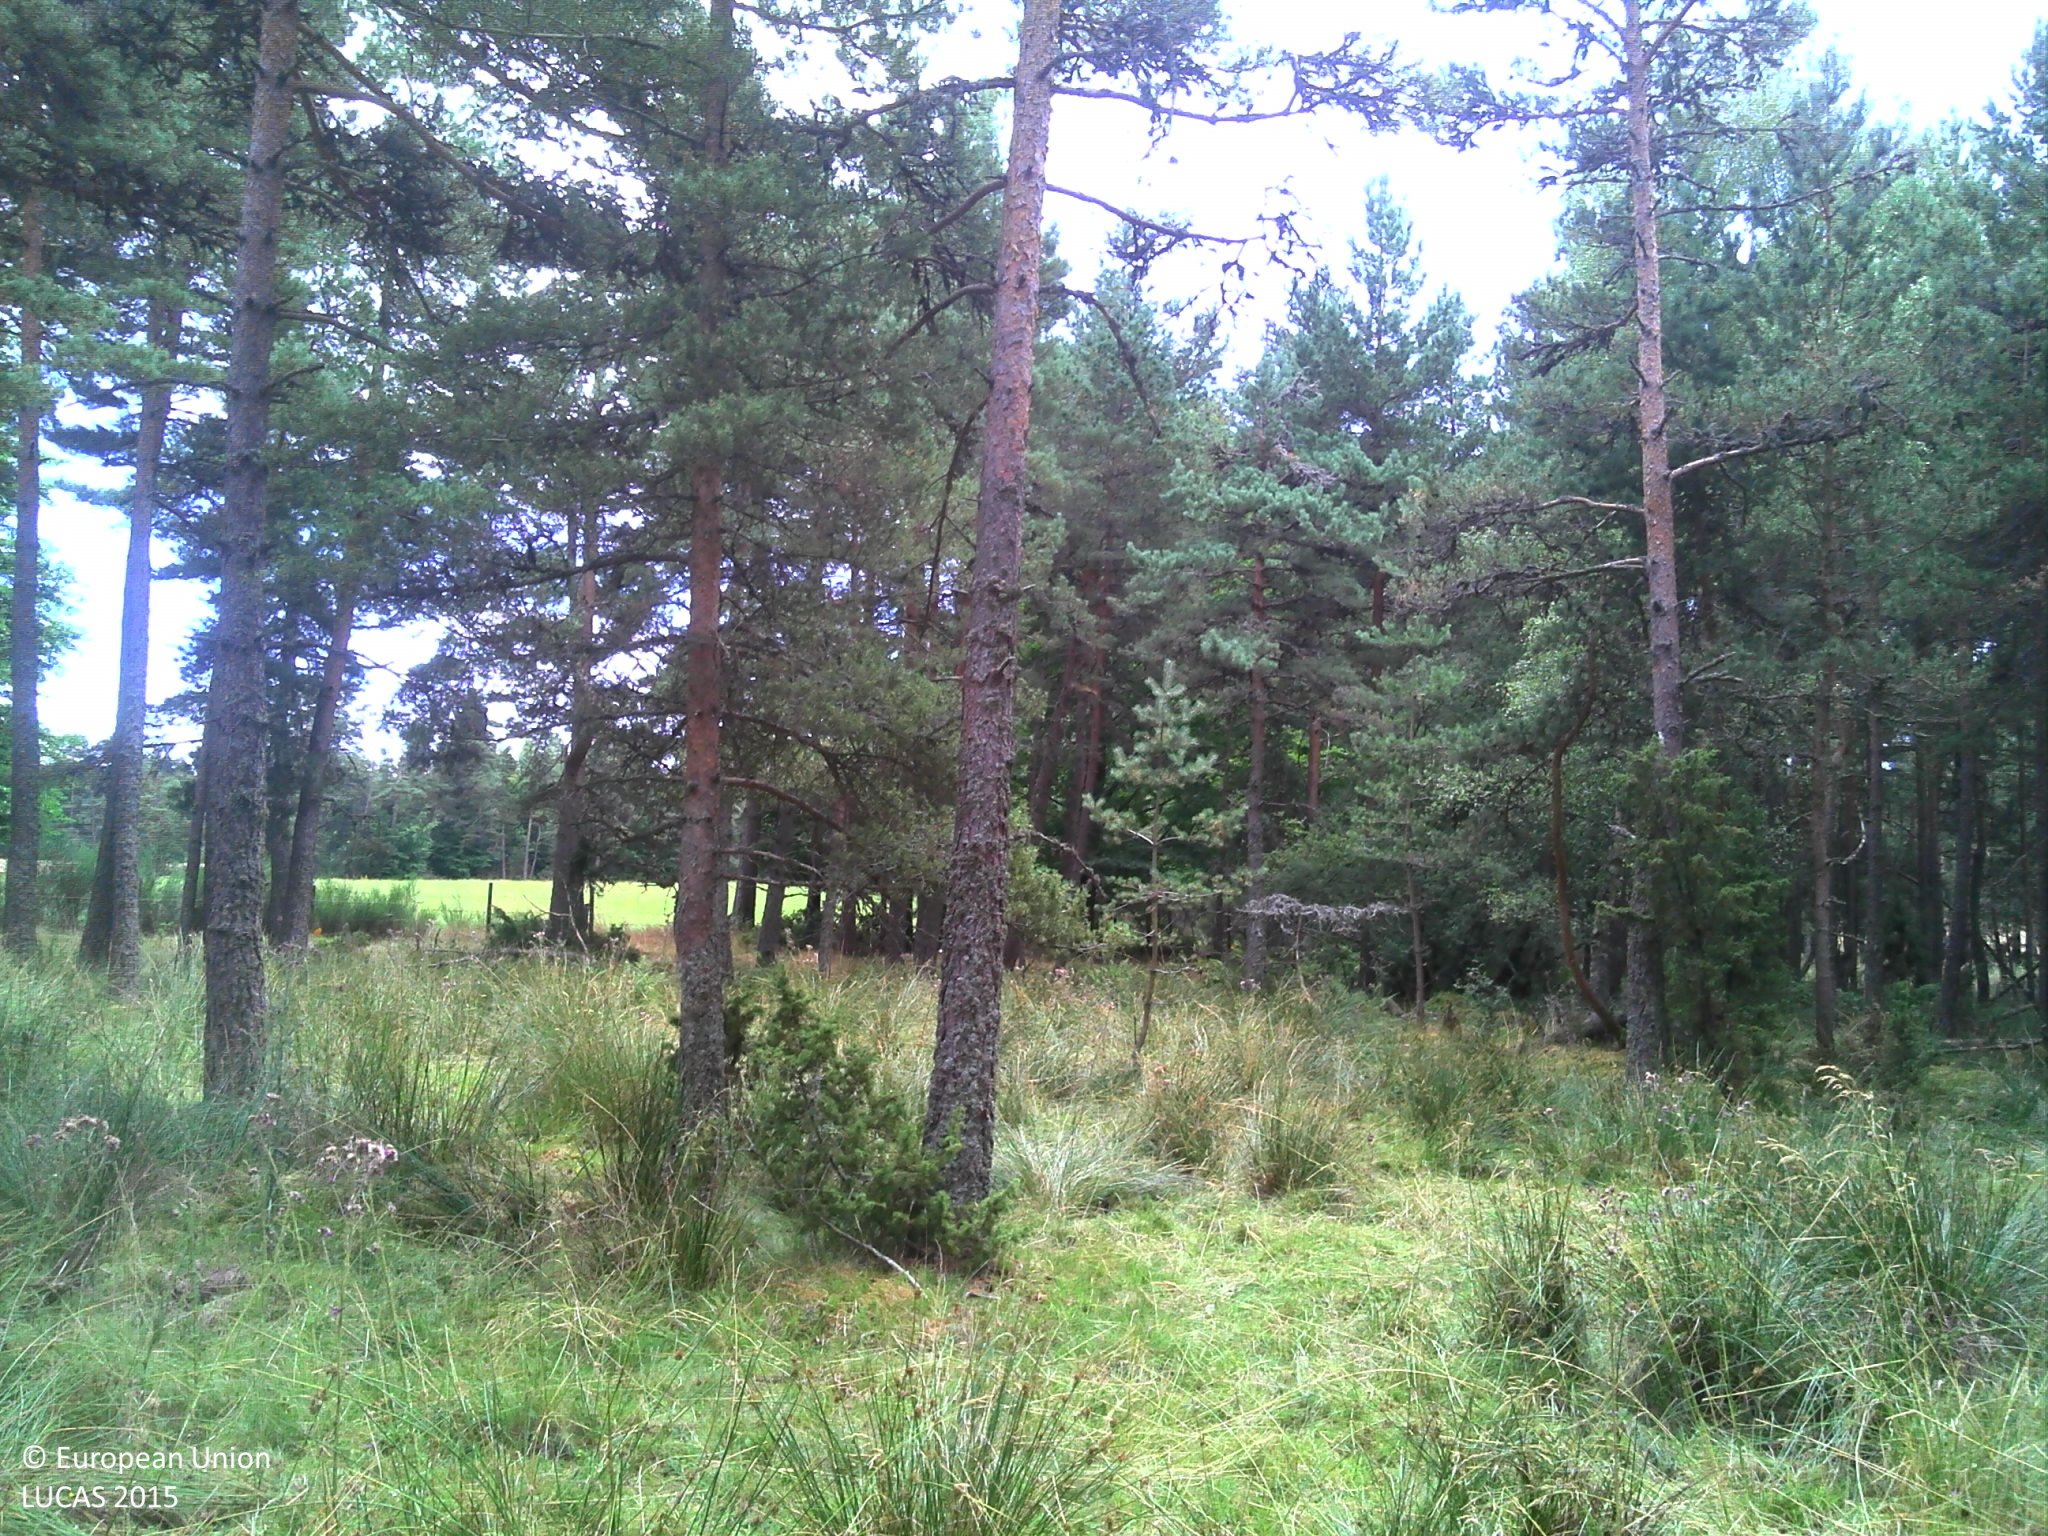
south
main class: Woodland
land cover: Pine dominated coniferous woodland
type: alpine coniferous forest
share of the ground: > 75 %
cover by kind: coniferous forest trees 75 %, broadleaved forest trees 25 %
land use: Forestry
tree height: > 5 m
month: July
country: FR
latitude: 44.8516
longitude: 3.2085
